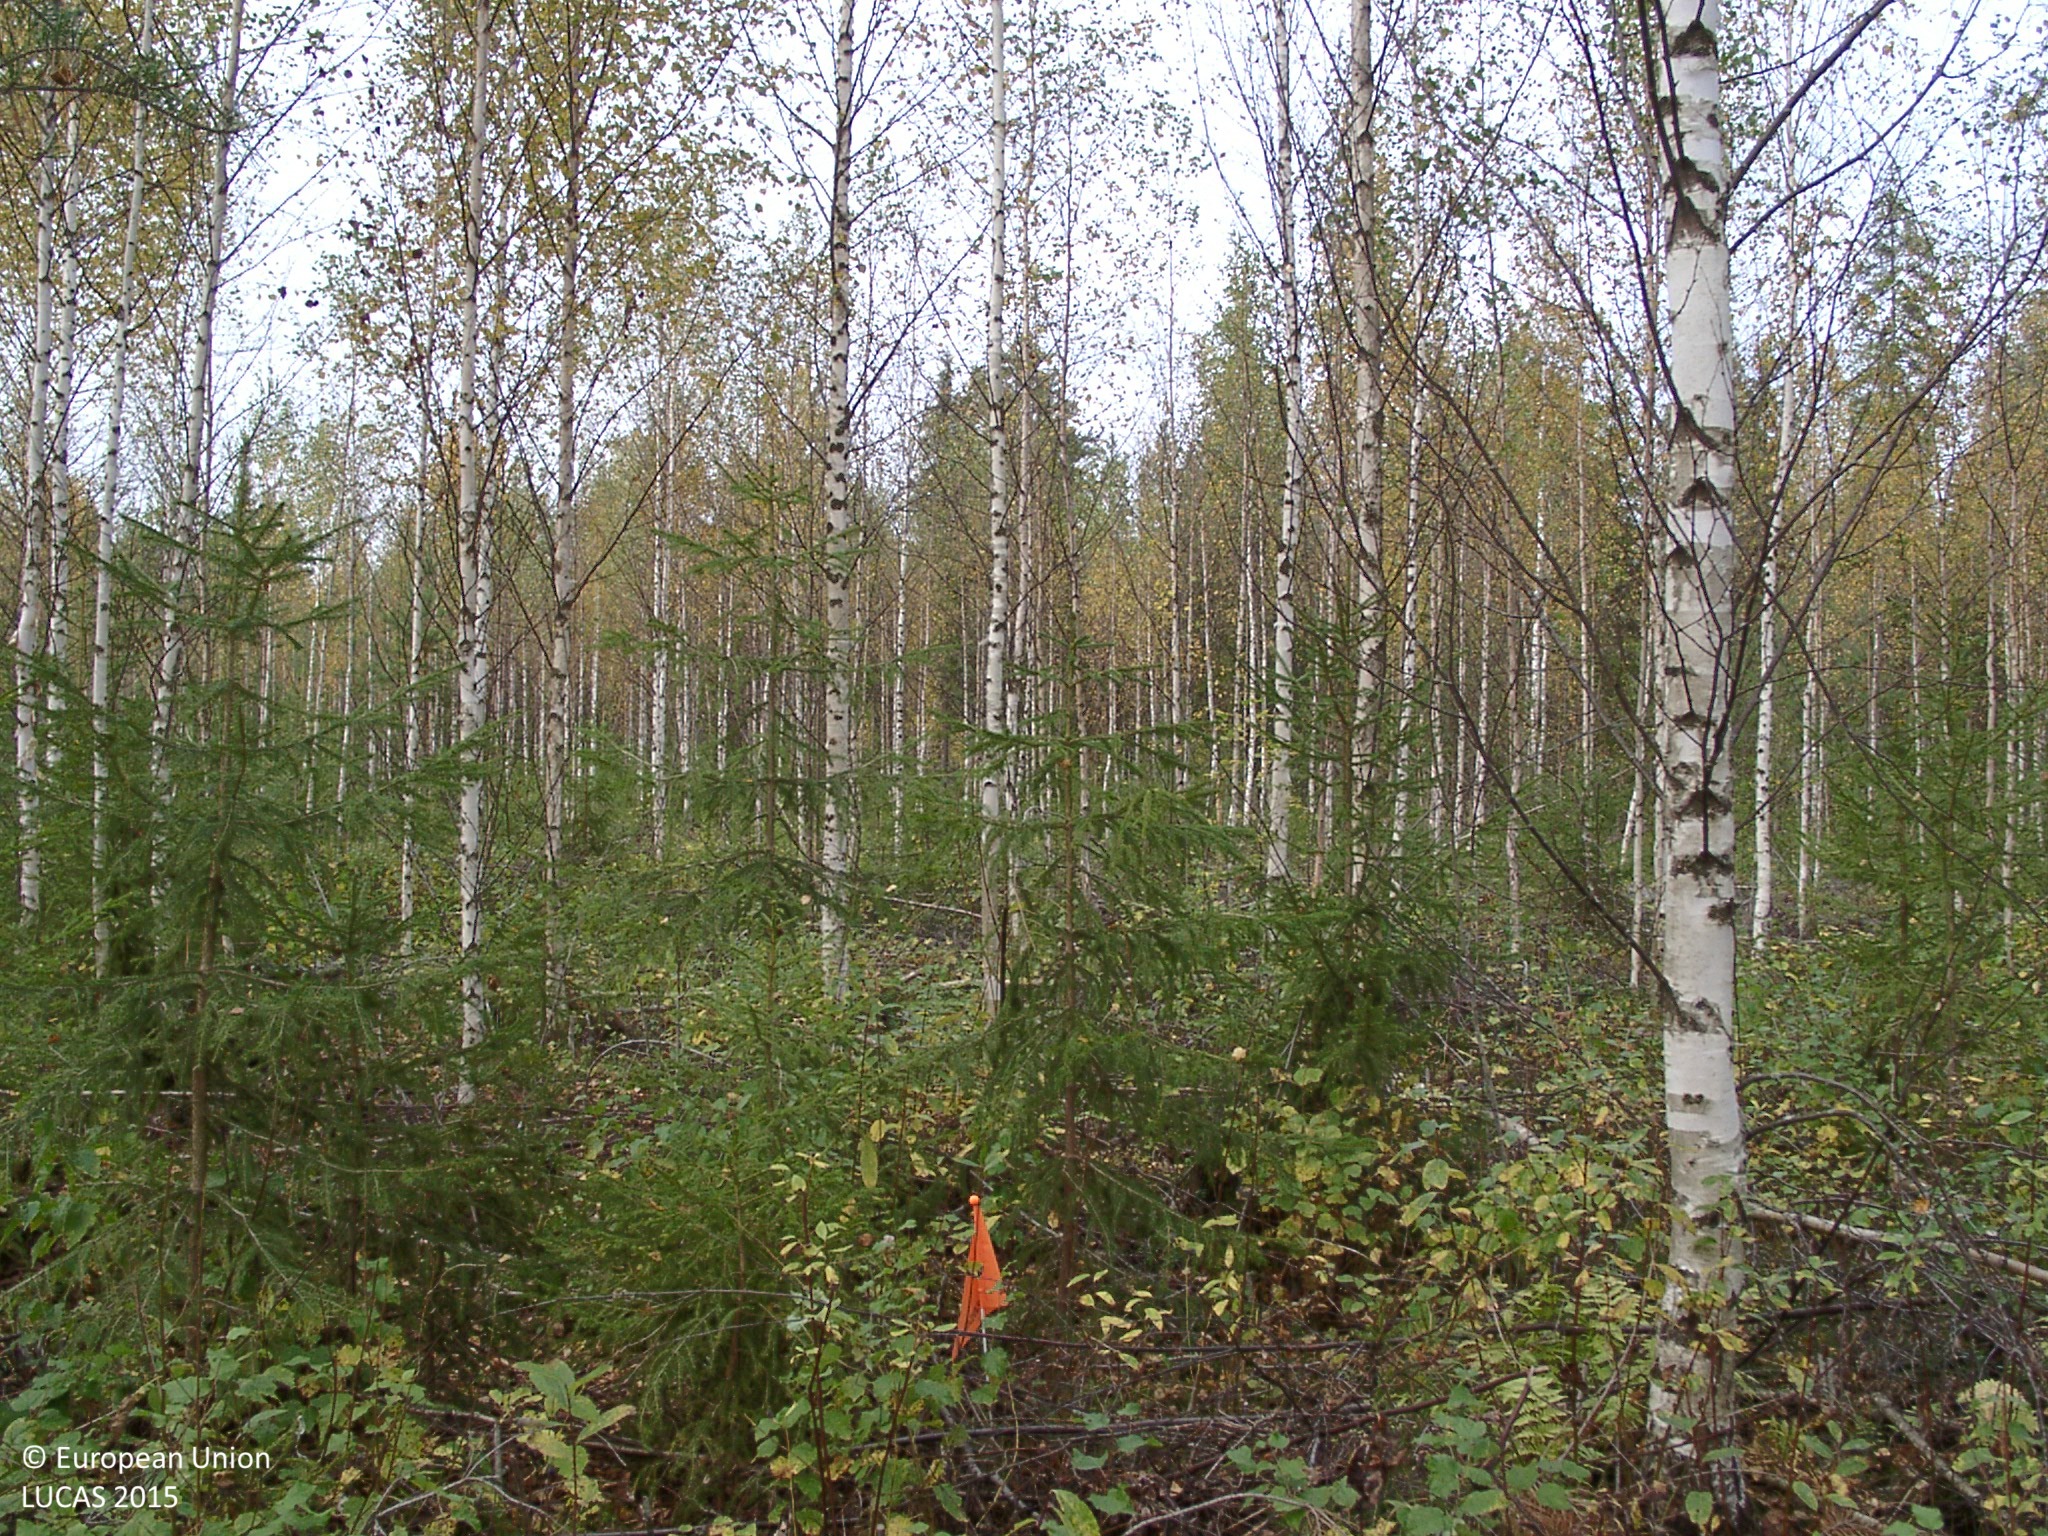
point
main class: Woodland
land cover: Spruce dominated mixed woodland
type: boreal forest
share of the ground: 50 - 75 %
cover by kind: broadleaved forest trees 60 %, coniferous forest trees 20 %, unconsolidated bare surface 10 %, shrubs 5 %, herbaceous plants 5 %
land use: Forestry
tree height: > 5 m
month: September
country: FI
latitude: 62.6623
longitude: 25.3907
